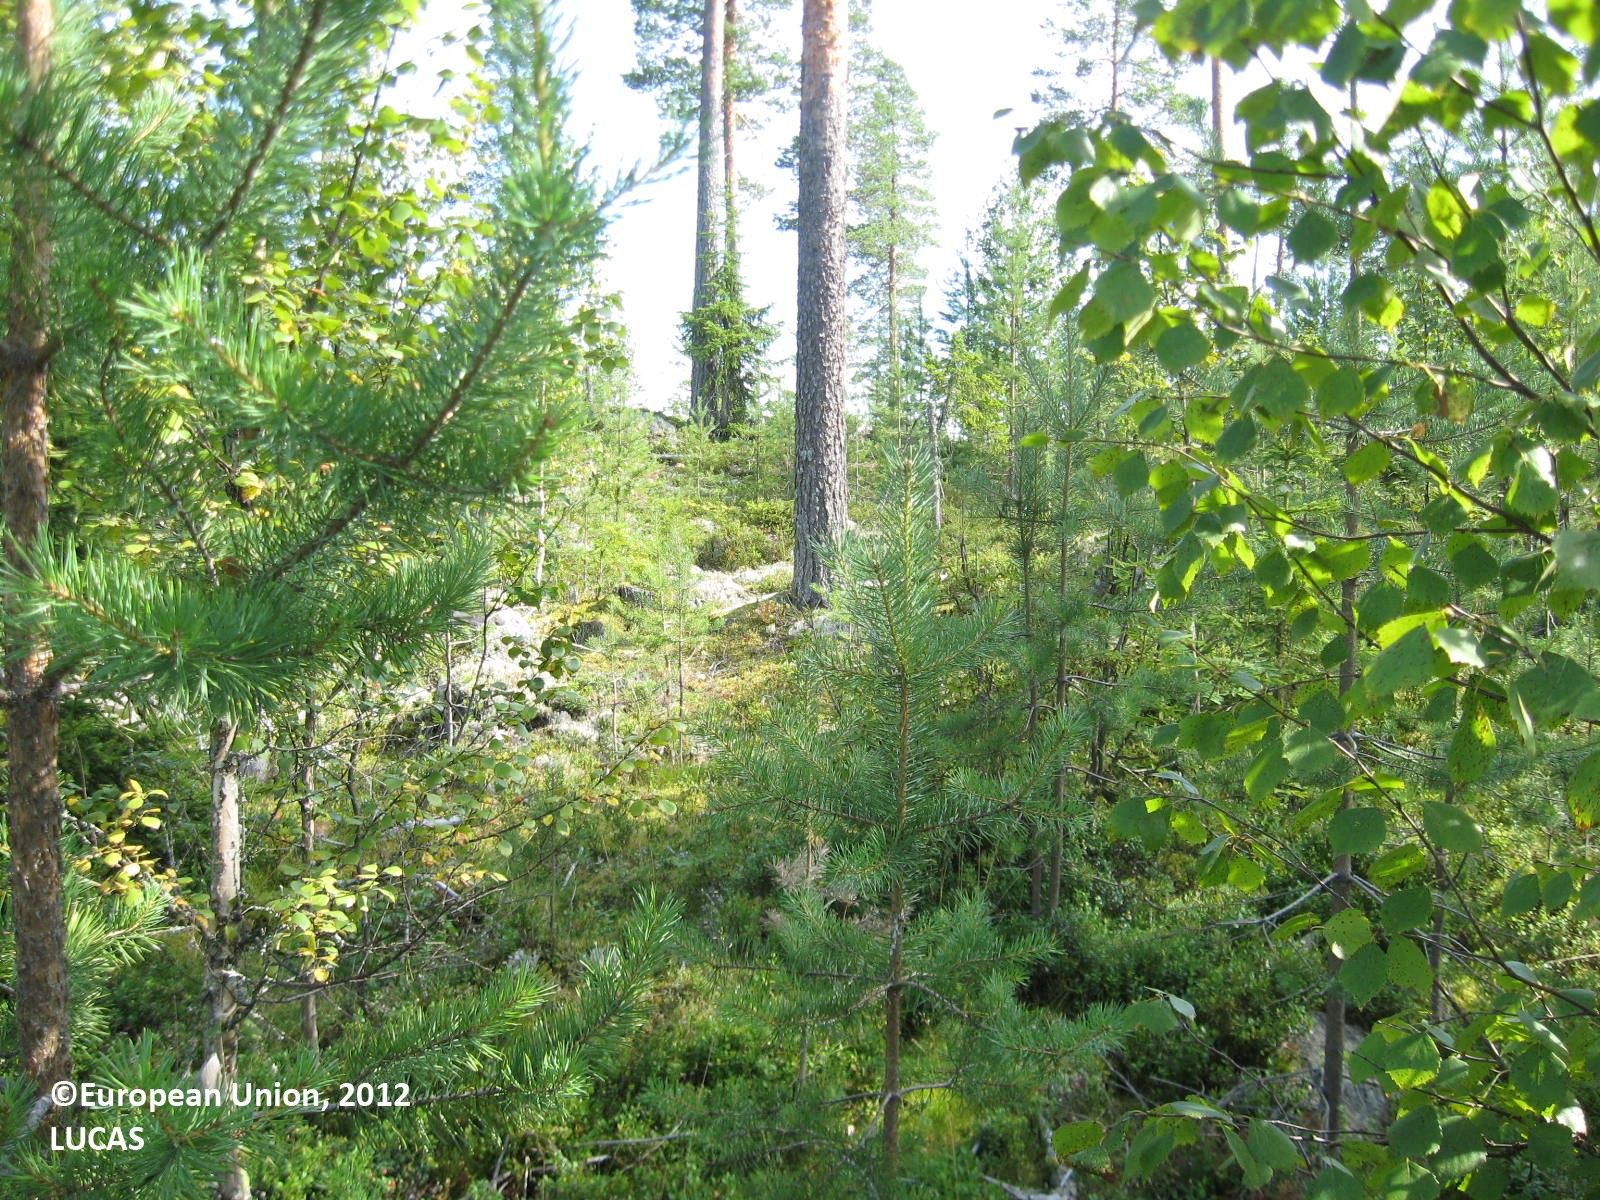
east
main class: Woodland
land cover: Pine dominated mixed woodland
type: boreal forest
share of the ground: > 75 %
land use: Forestry
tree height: > 5 m
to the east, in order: Pine dominated mixed woodland
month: August
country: FI
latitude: 63.8590
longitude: 28.7679
